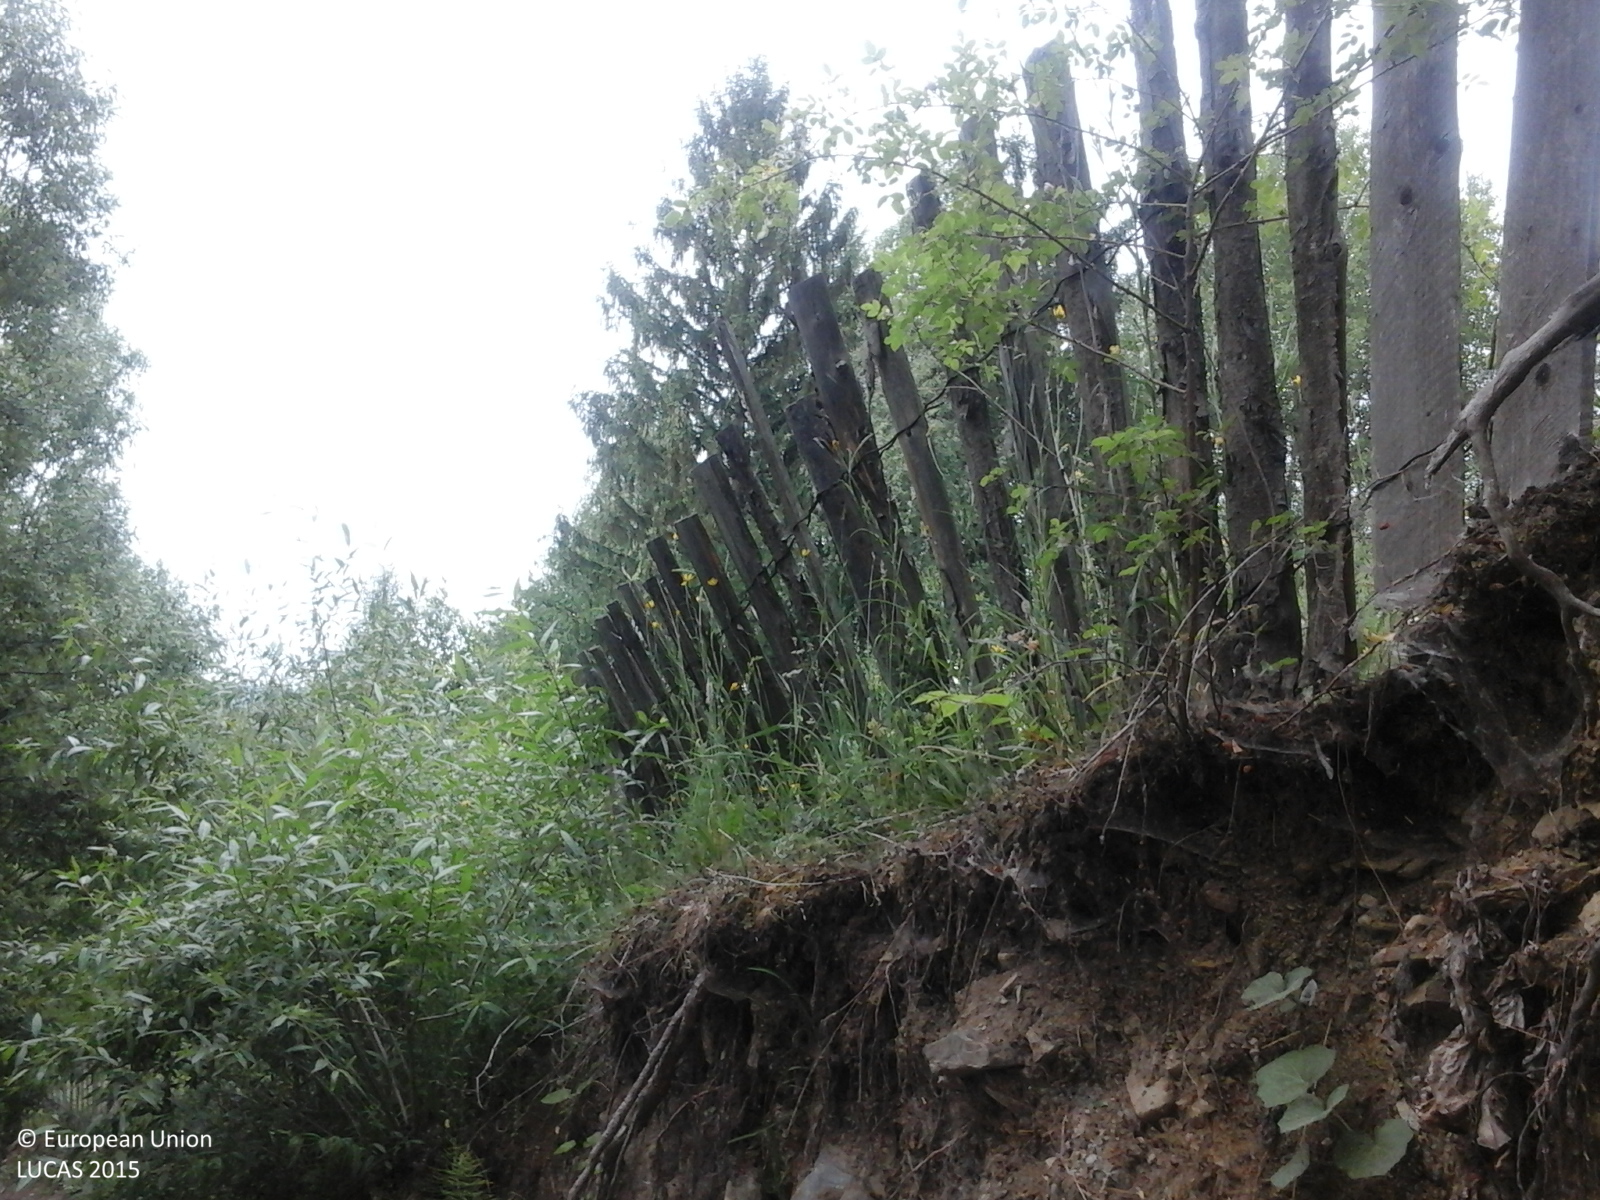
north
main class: Grassland
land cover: Grassland without tree/shrub cover
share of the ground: > 75 %
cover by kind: herbaceous plants 100 %
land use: Agriculture (excluding fallow land and kitchen gardens)
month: June
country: RO
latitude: 47.4963
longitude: 25.8004
